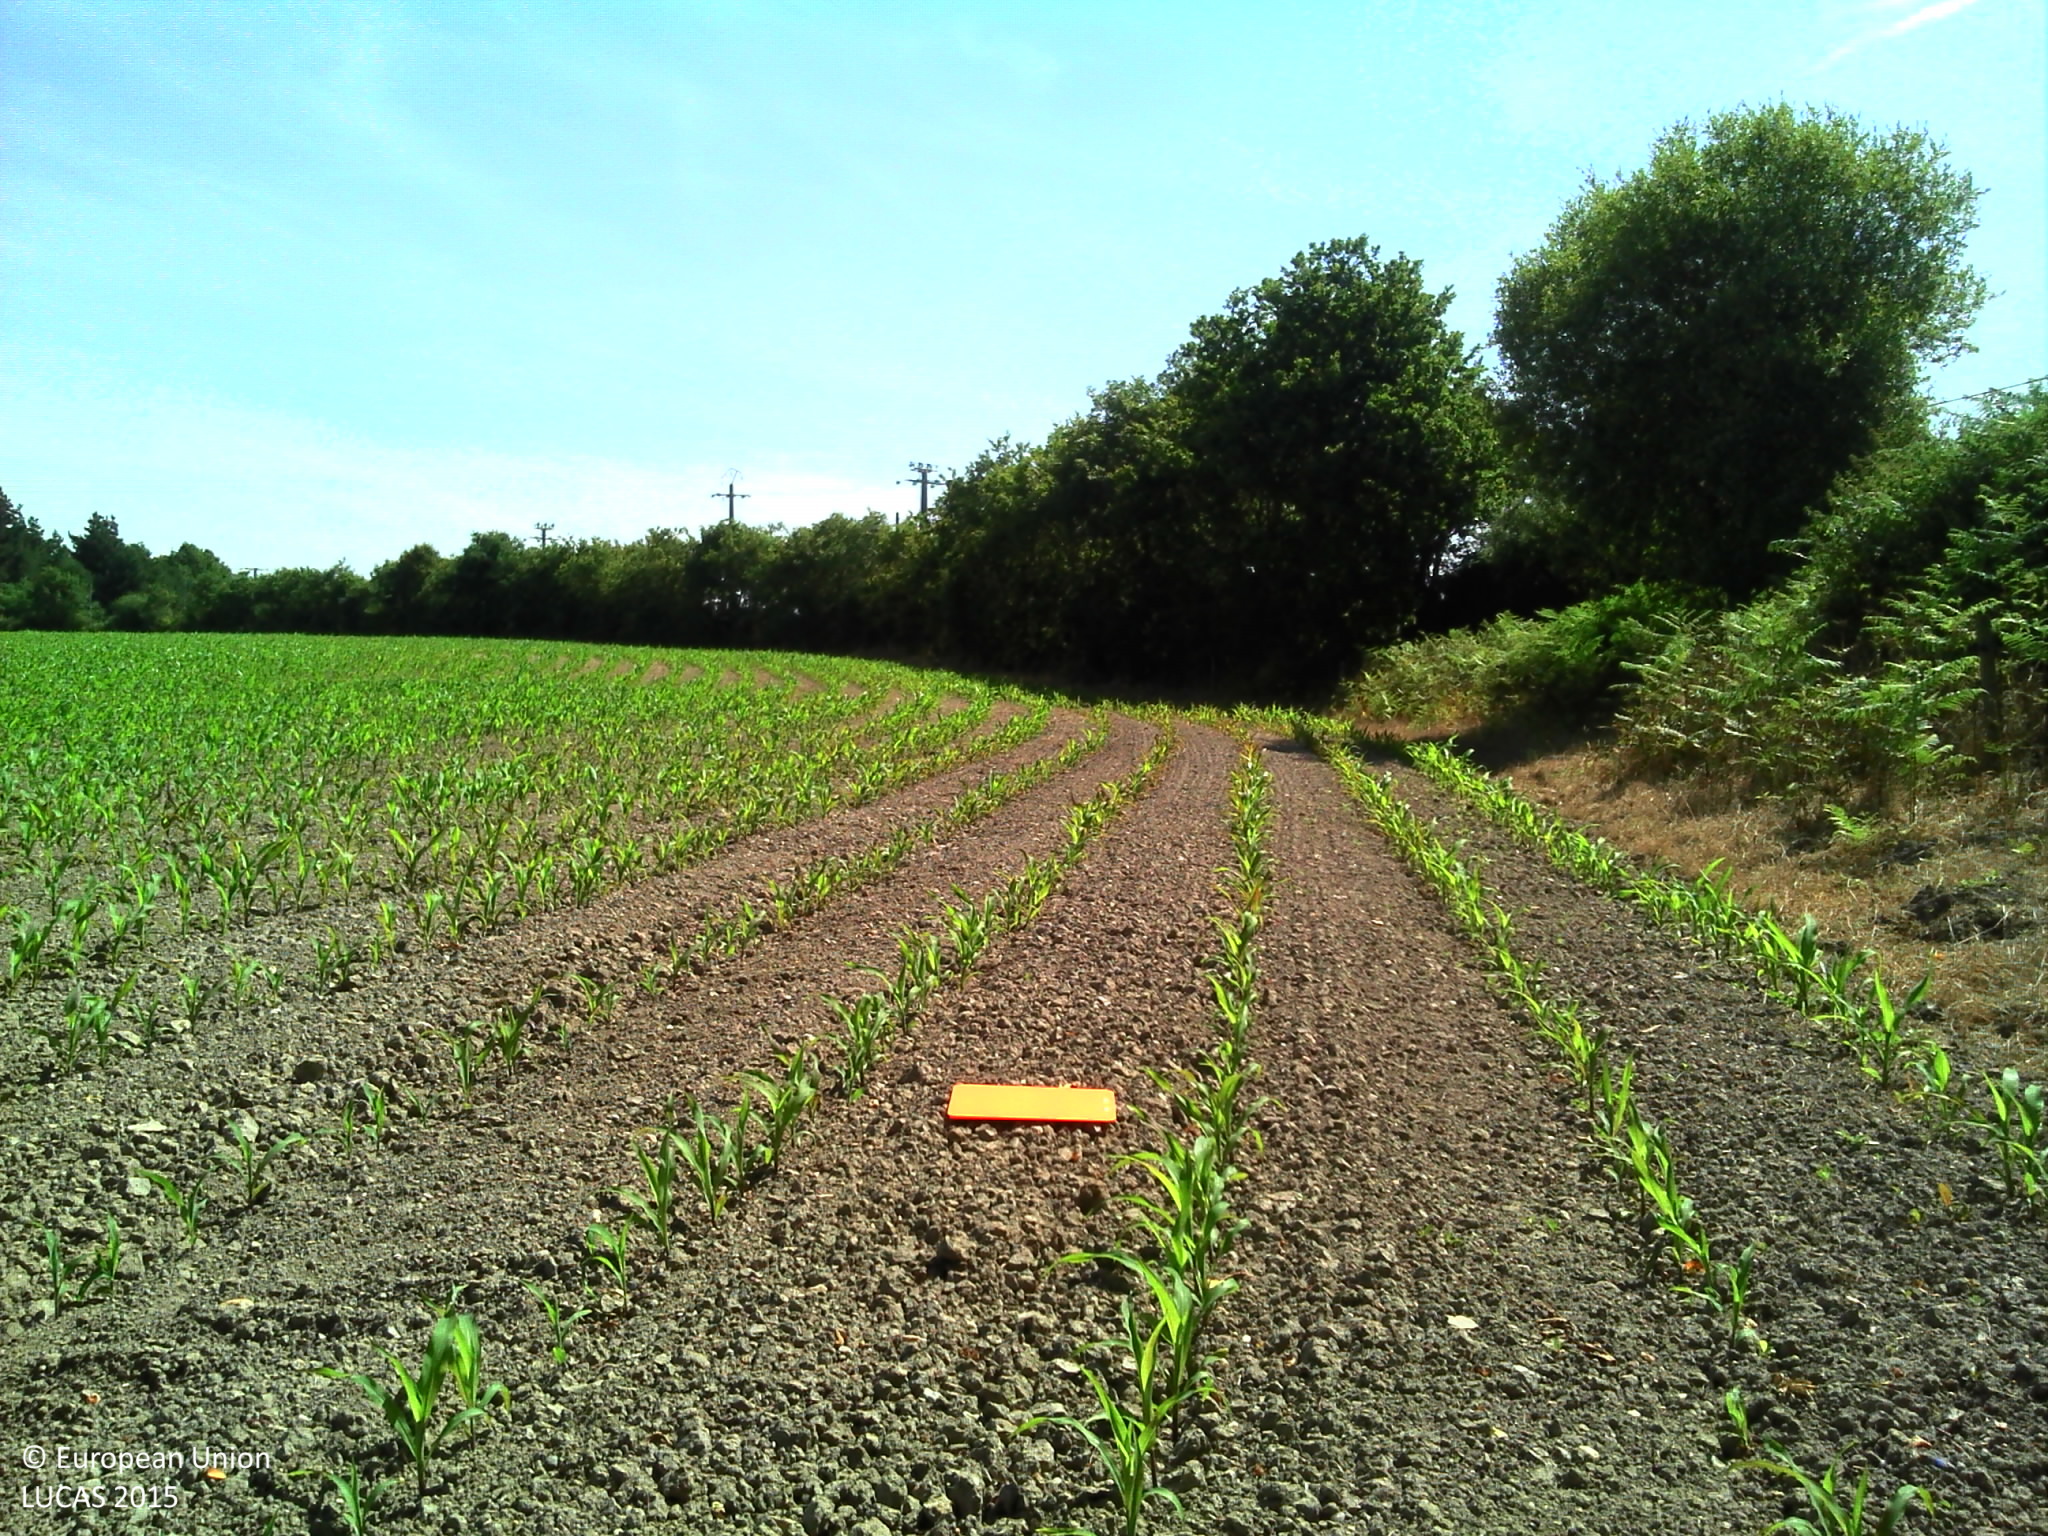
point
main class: Cropland
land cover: Maize
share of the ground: 25 - 50 %
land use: Agriculture (excluding fallow land and kitchen gardens)
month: June
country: FR
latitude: 46.9263
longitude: -1.6915
